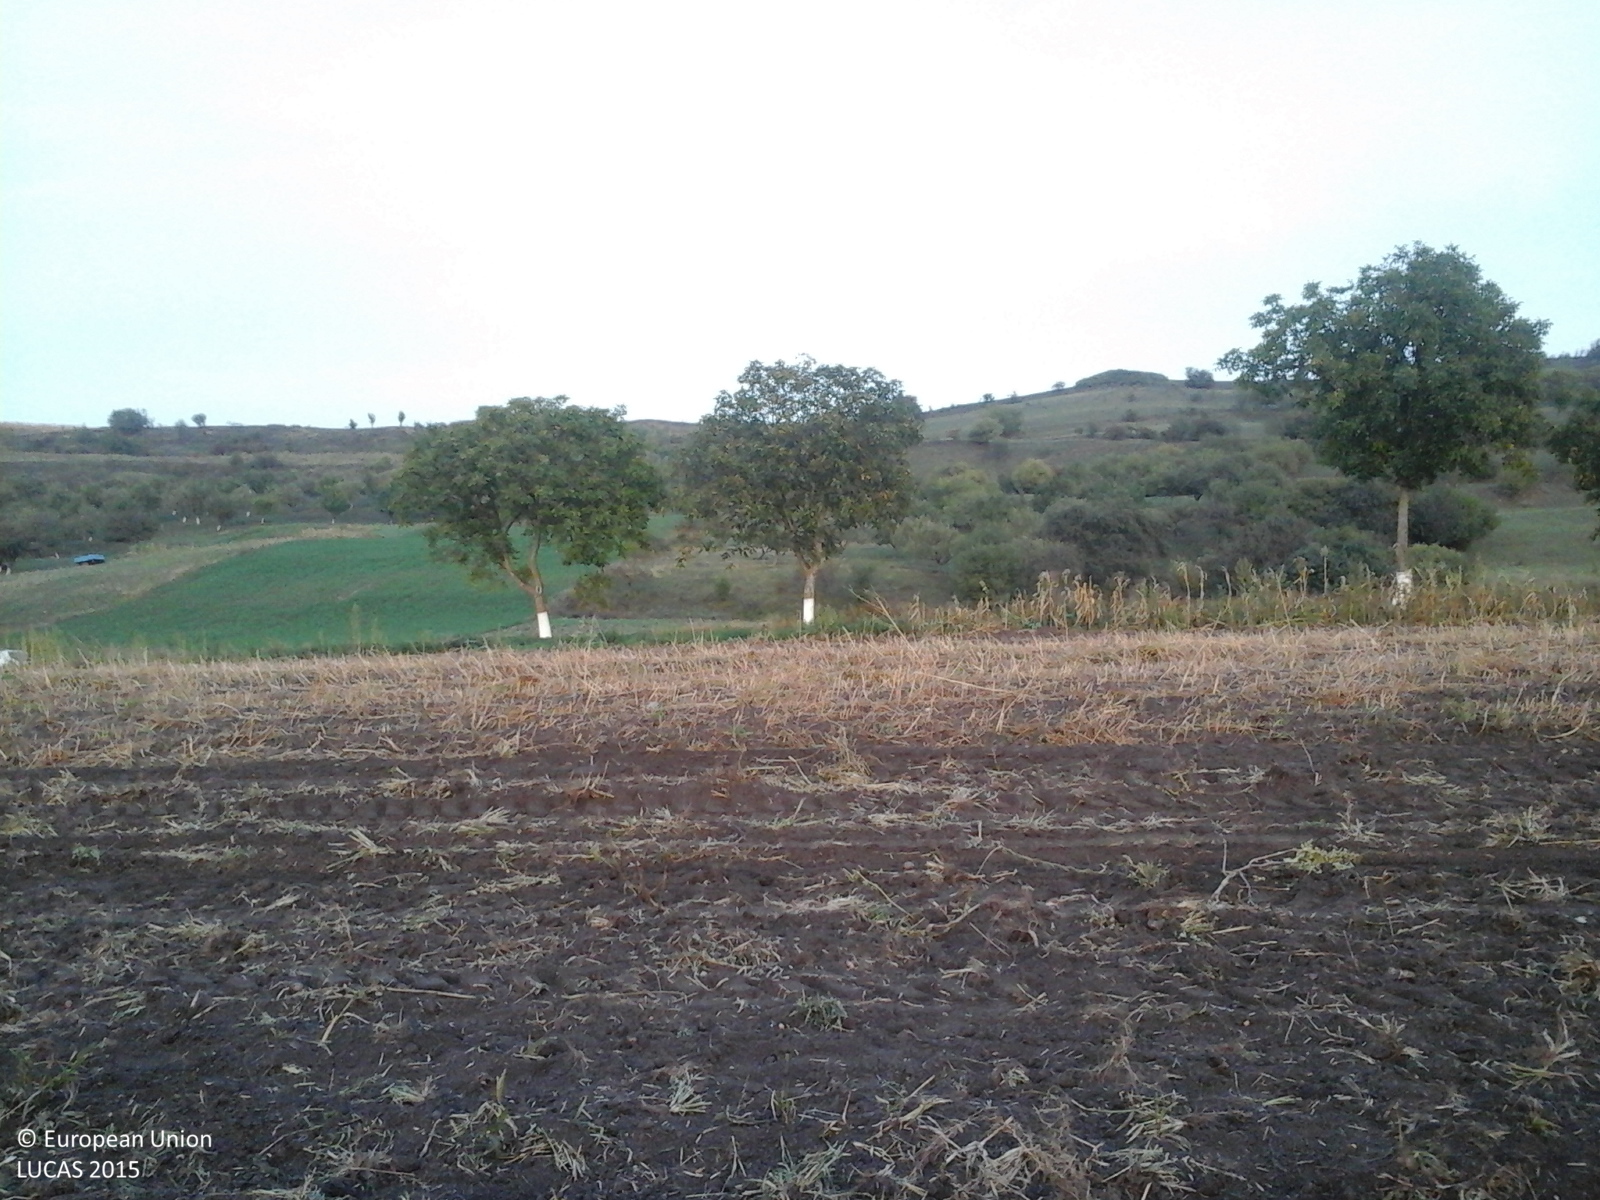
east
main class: Cropland
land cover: Potatoes
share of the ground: < 10 %
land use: Agriculture (excluding fallow land and kitchen gardens)
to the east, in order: Potatoes; Grass margins; Paved roads, cycling and walking lanes; Grass margins; Durum wheat; Apple fruit
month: September
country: RO
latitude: 46.5758
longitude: 24.0000
